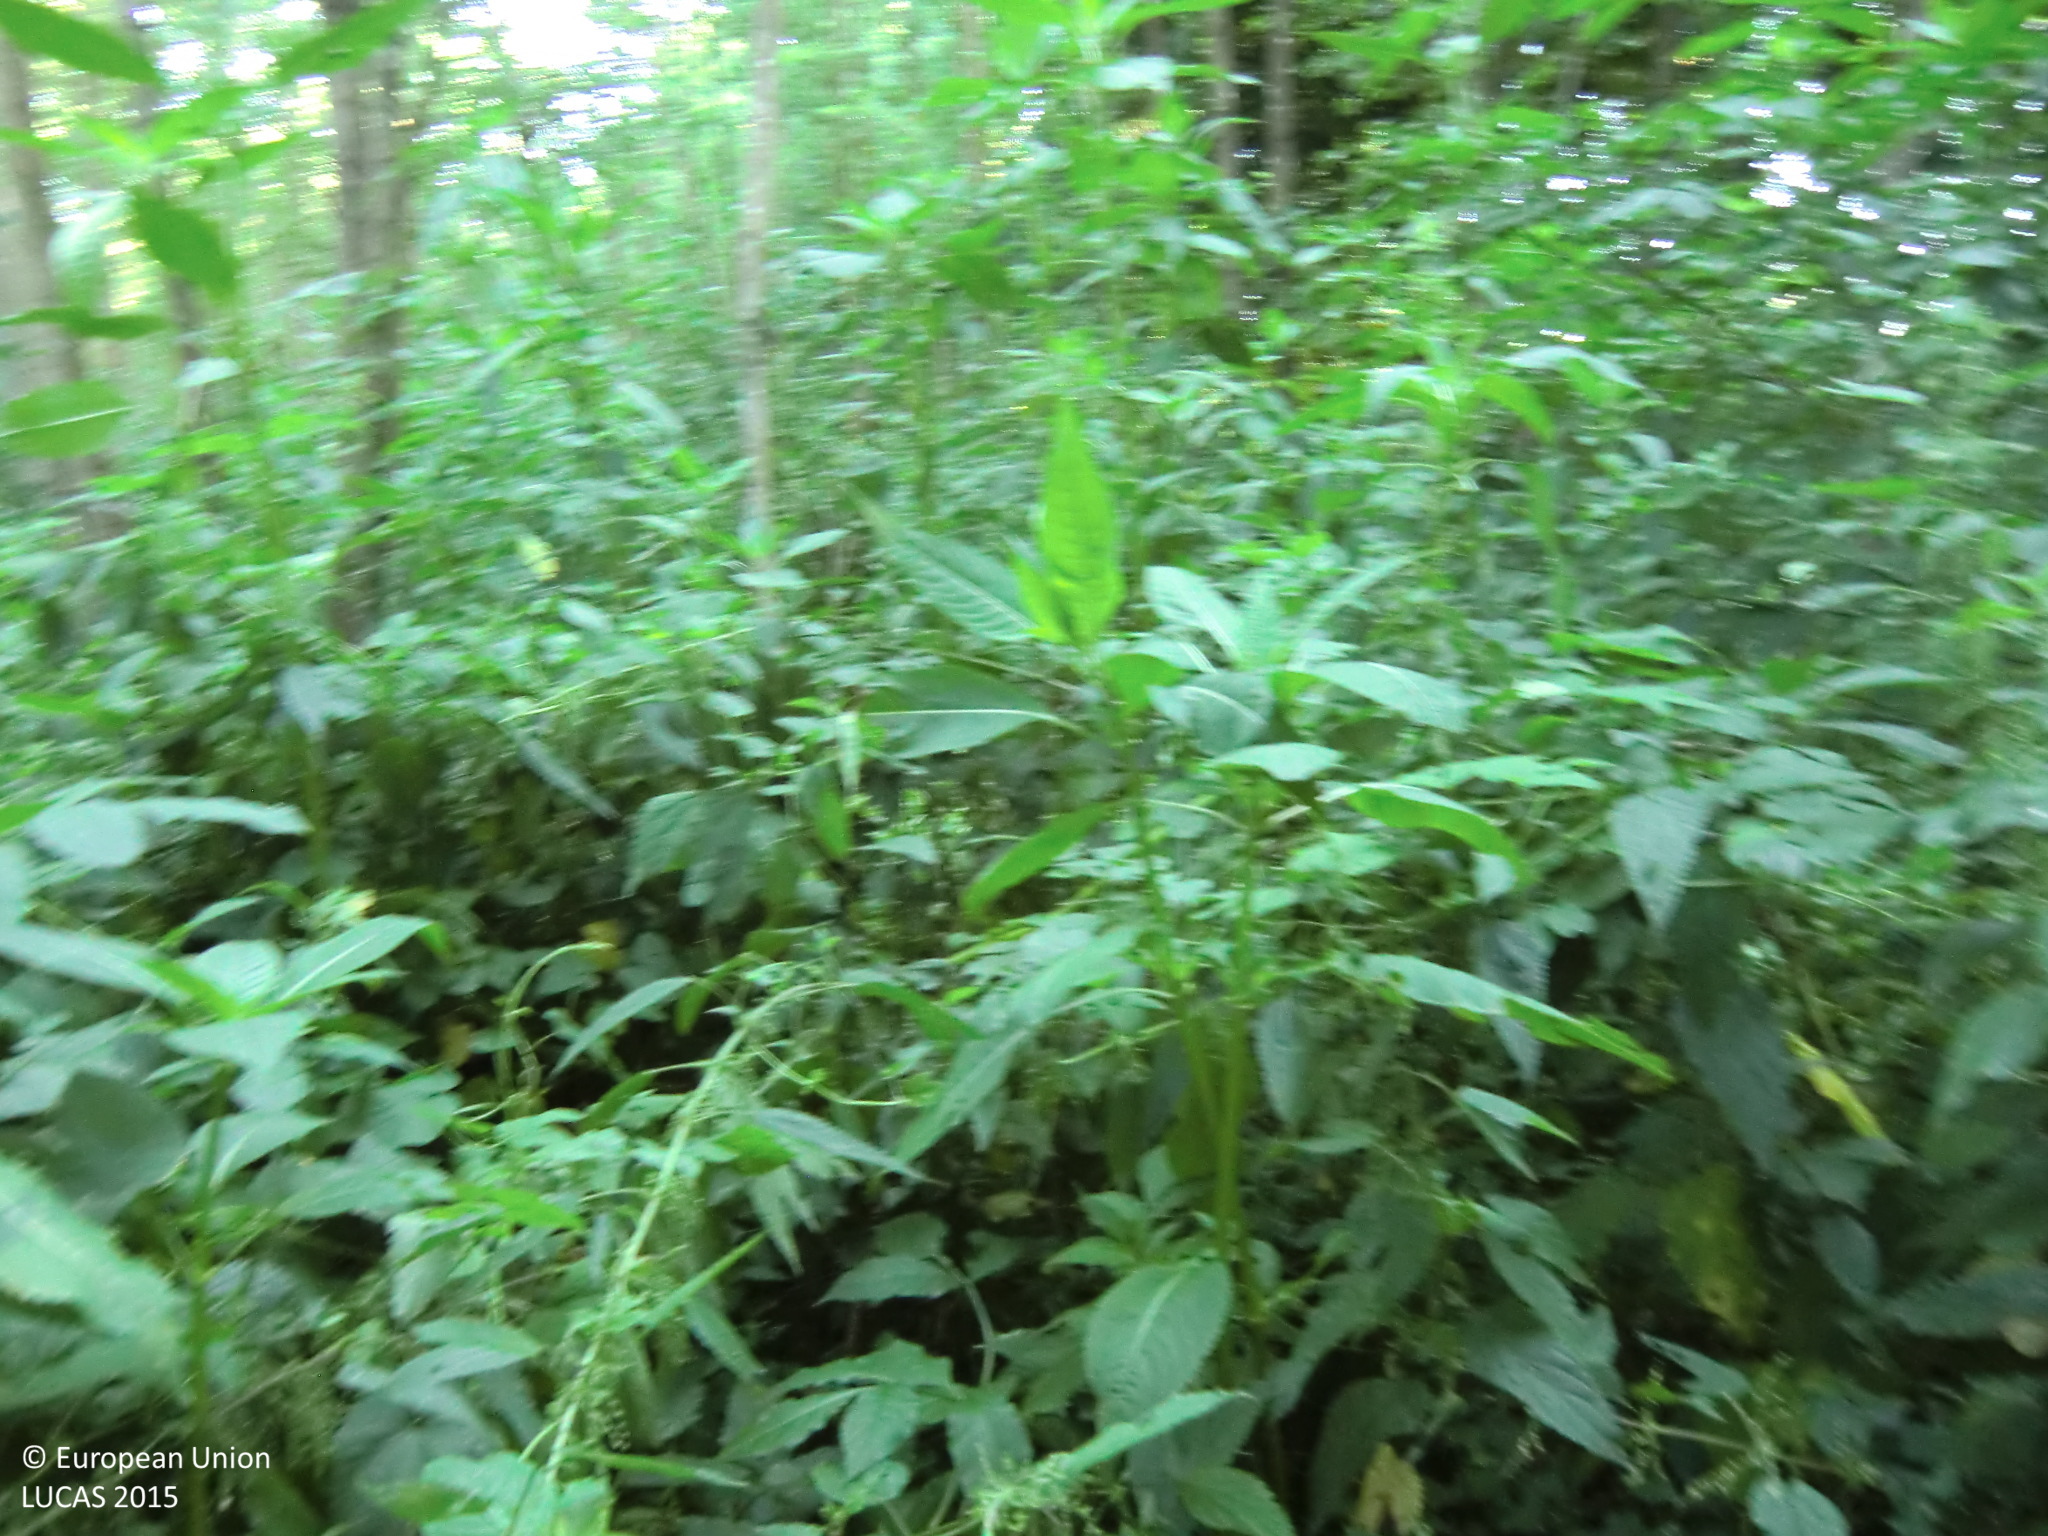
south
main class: Woodland
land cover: Broadleaved woodland
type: floodplain forest
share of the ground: > 75 %
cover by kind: broadleaved forest trees 75 %, herbaceous plants 25 %
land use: Forestry
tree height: > 5 m
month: July
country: AT
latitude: 47.0247
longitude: 16.1195
